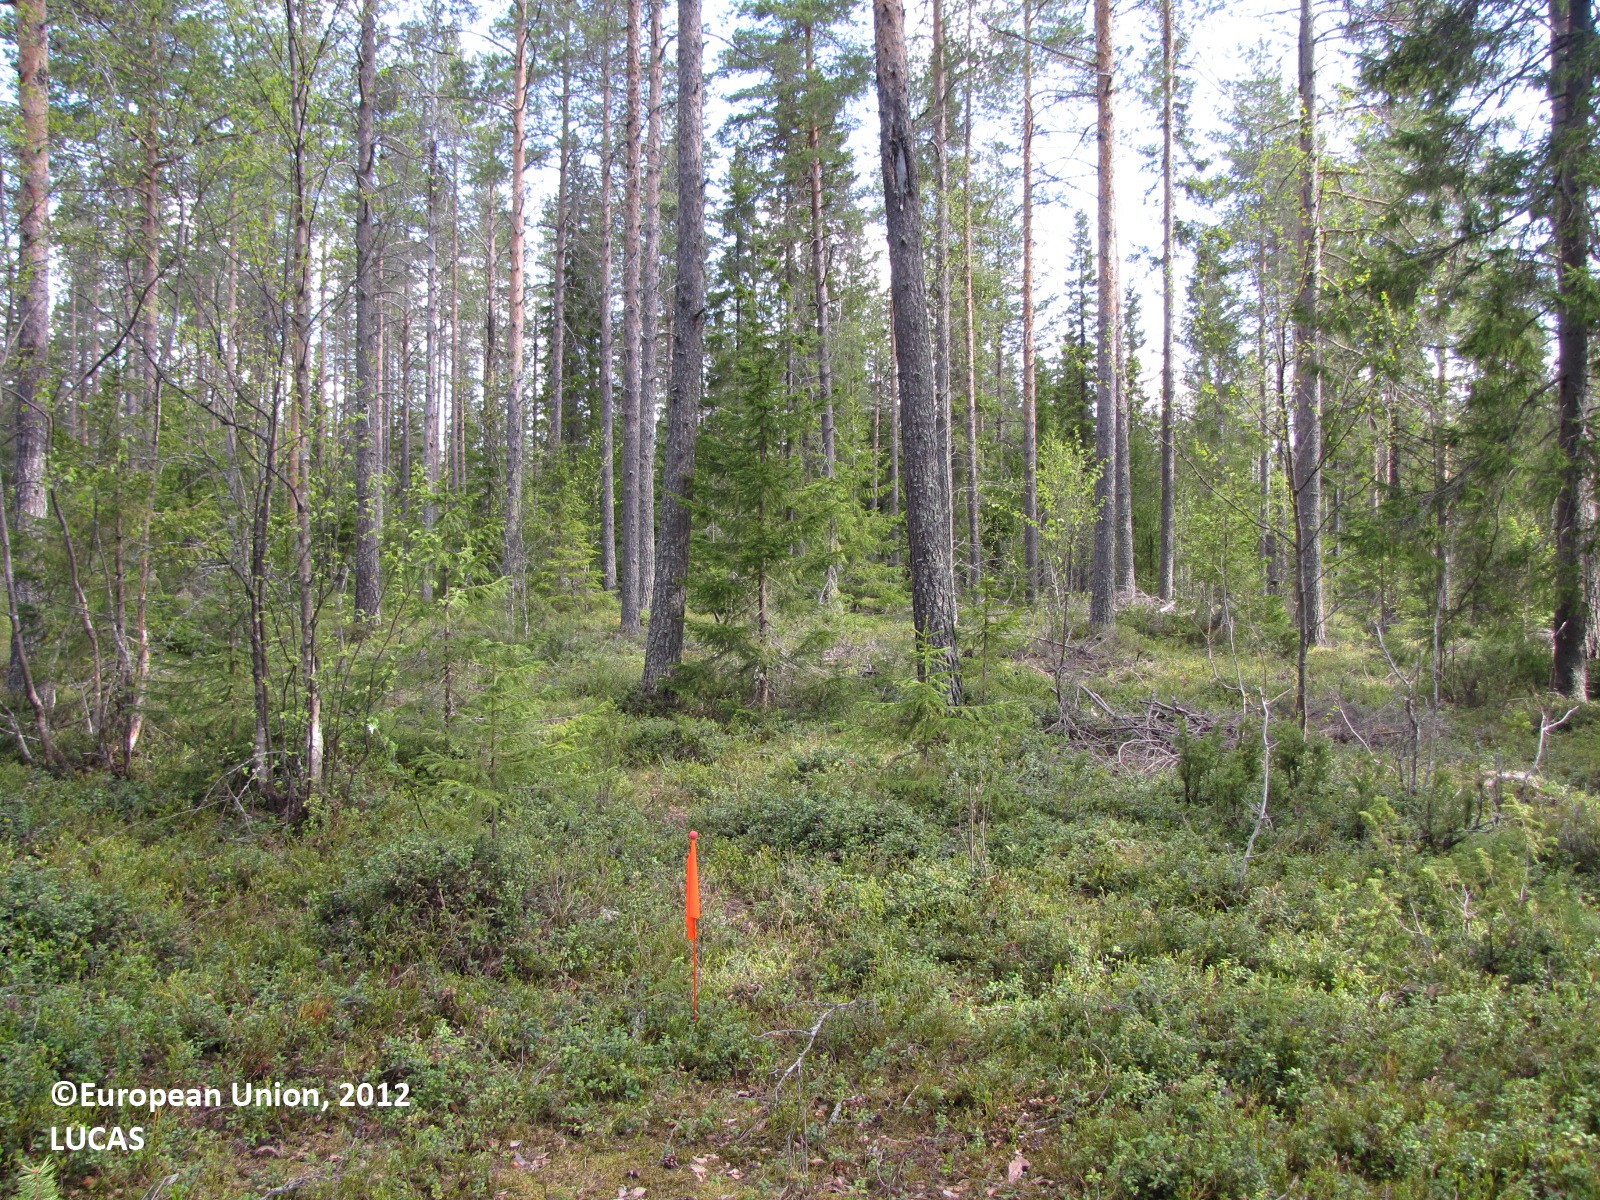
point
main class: Woodland
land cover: Pine dominated mixed woodland
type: boreal forest
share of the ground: > 75 %
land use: Forestry
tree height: > 5 m
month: June
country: FI
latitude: 65.7645
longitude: 24.6184
